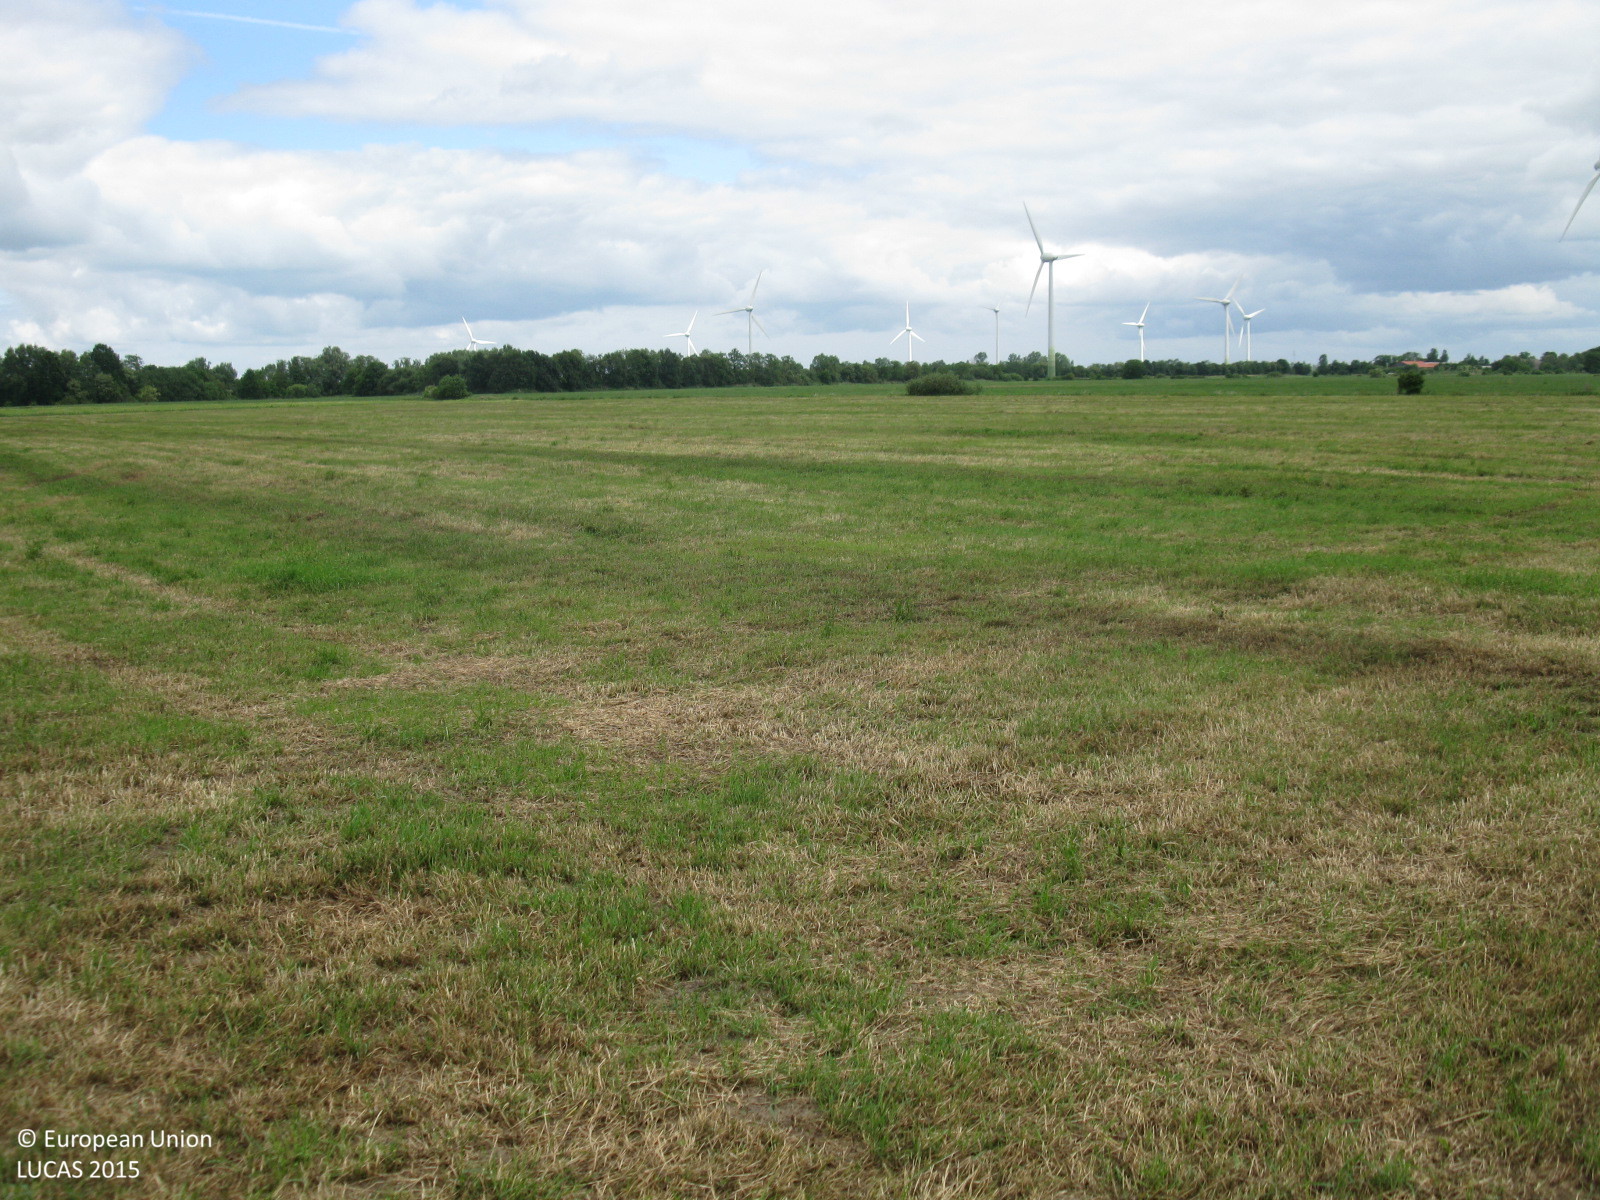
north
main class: Grassland
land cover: Grassland without tree/shrub cover
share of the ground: > 75 %
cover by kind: herbaceous plants 100 %
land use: Agriculture (excluding fallow land and kitchen gardens)
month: June
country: DE
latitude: 53.3022
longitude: 7.4046
